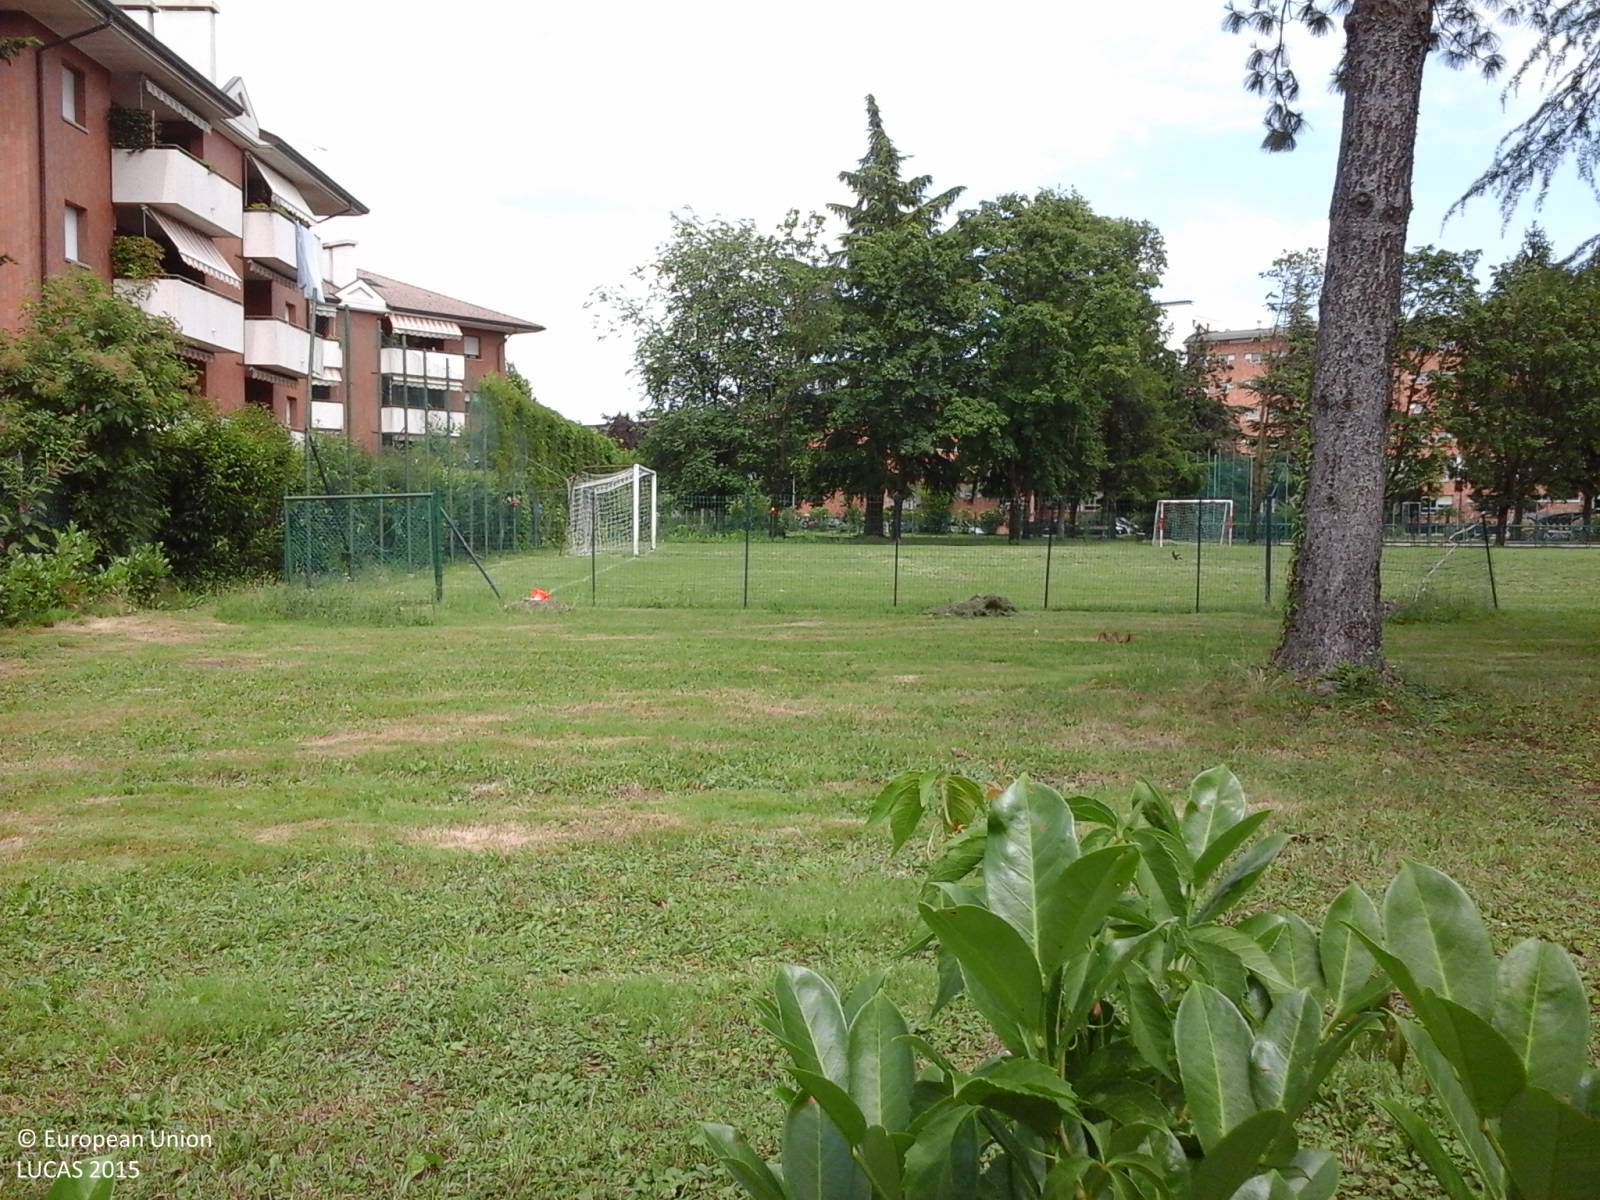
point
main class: Grassland
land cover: Grassland without tree/shrub cover
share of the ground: > 75 %
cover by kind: herbaceous plants 100 %
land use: Sport
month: June
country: IT
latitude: 46.0685
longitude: 13.2156
